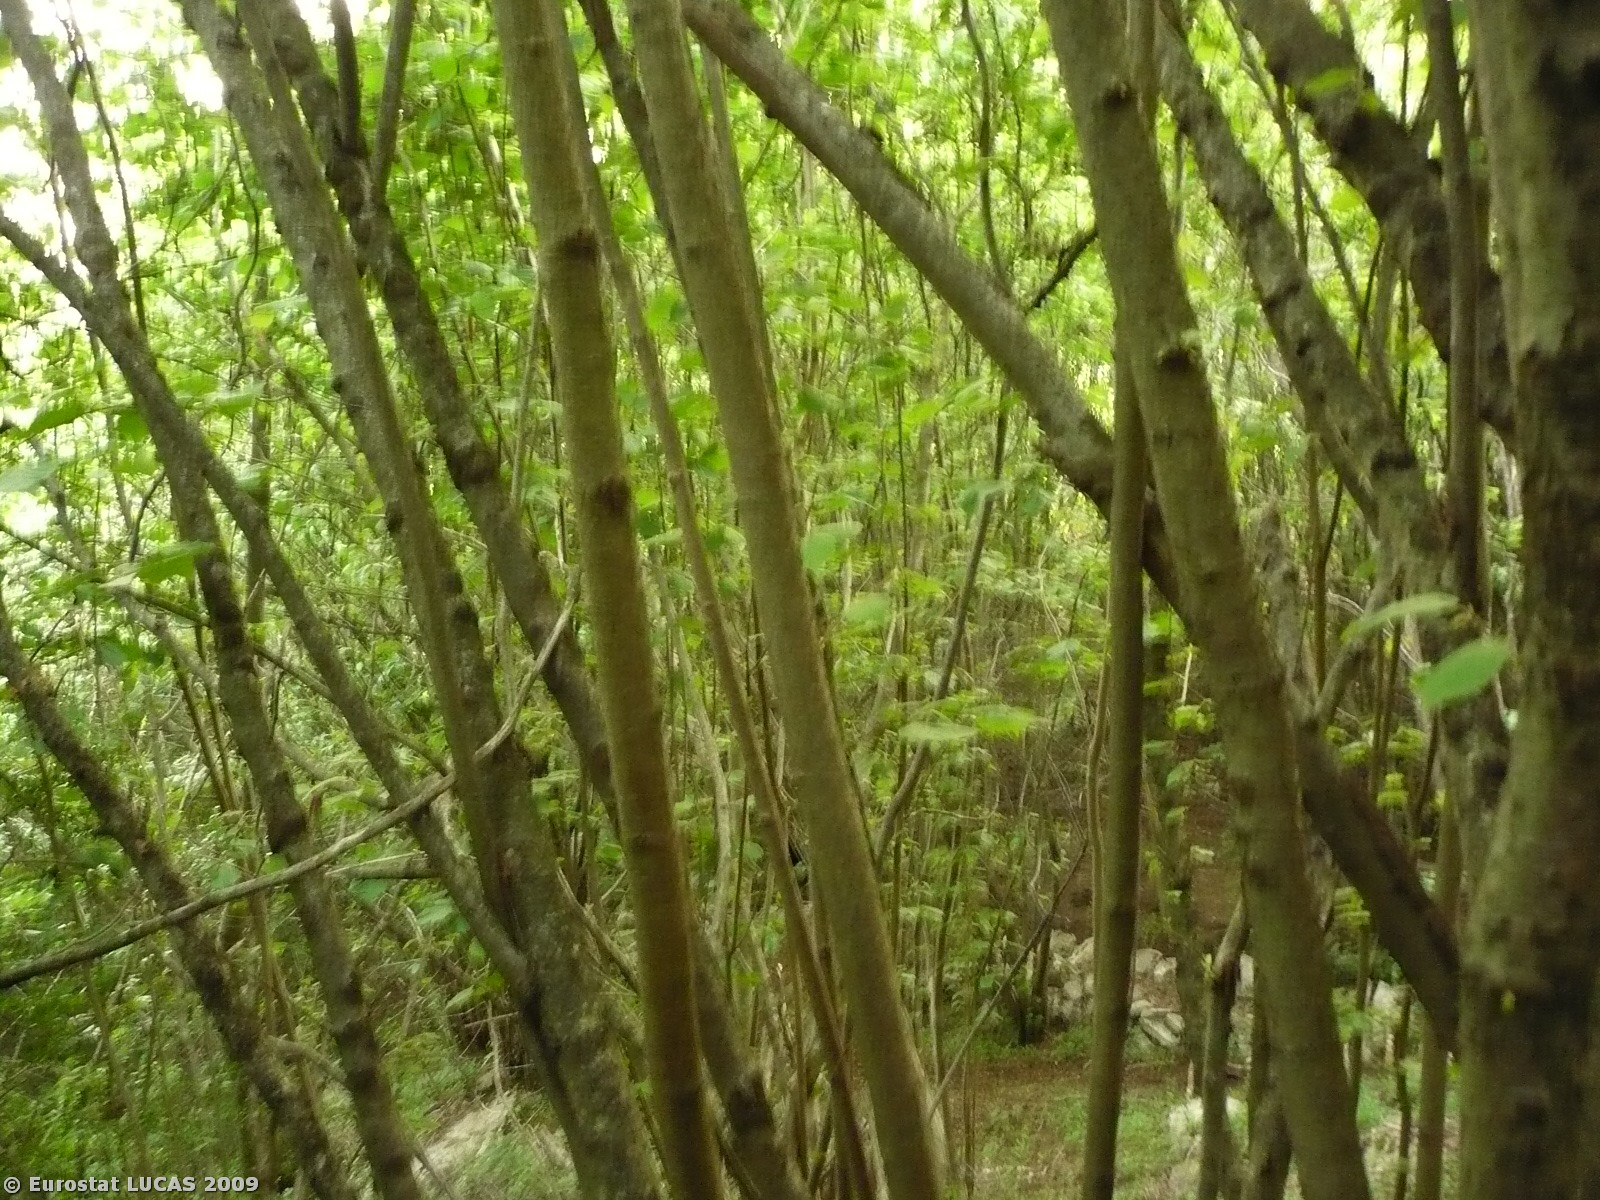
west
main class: Woodland
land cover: Broadleaved woodland
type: thermophilous deciduous forest
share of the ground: > 75 %
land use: Agriculture (excluding fallow land and kitchen gardens)
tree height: > 5 m
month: May
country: SI
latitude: 46.0535
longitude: 13.6799
